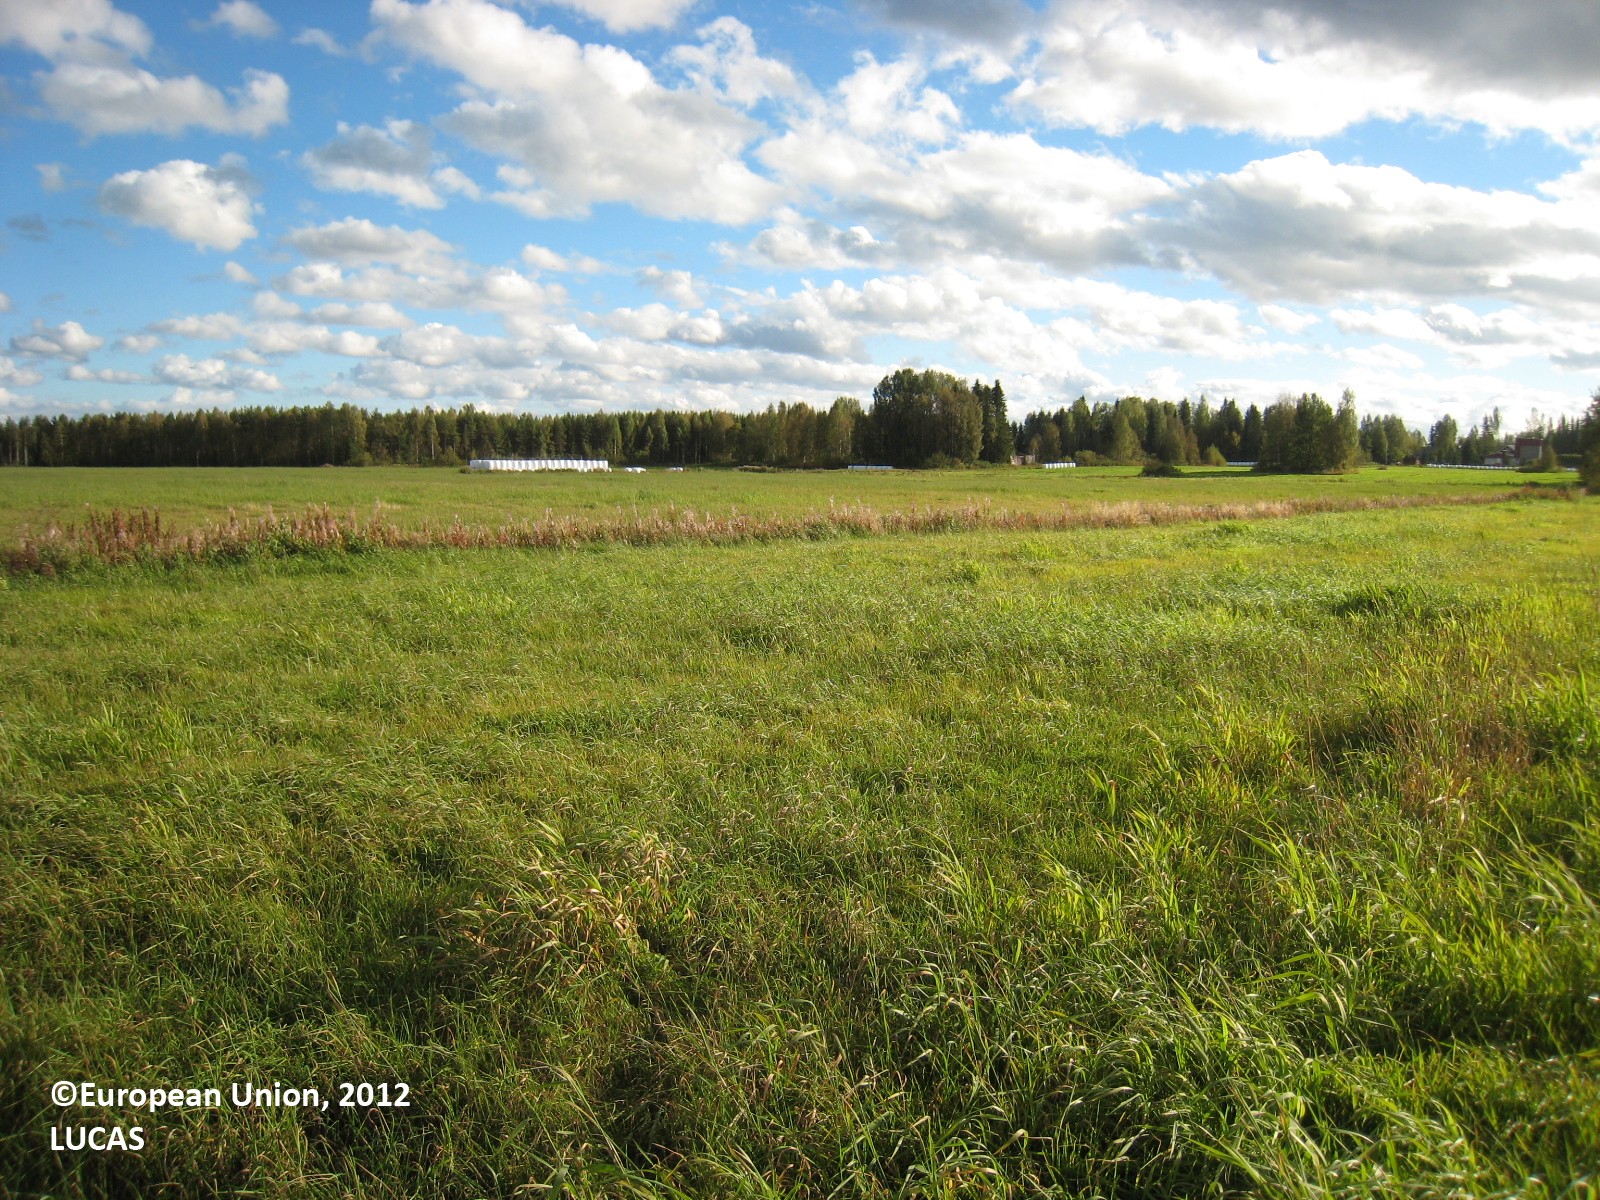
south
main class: Cropland
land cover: Temporary grasslands
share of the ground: > 75 %
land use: Agriculture (excluding fallow land and kitchen gardens)
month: September
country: FI
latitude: 63.1113
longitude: 26.8891
